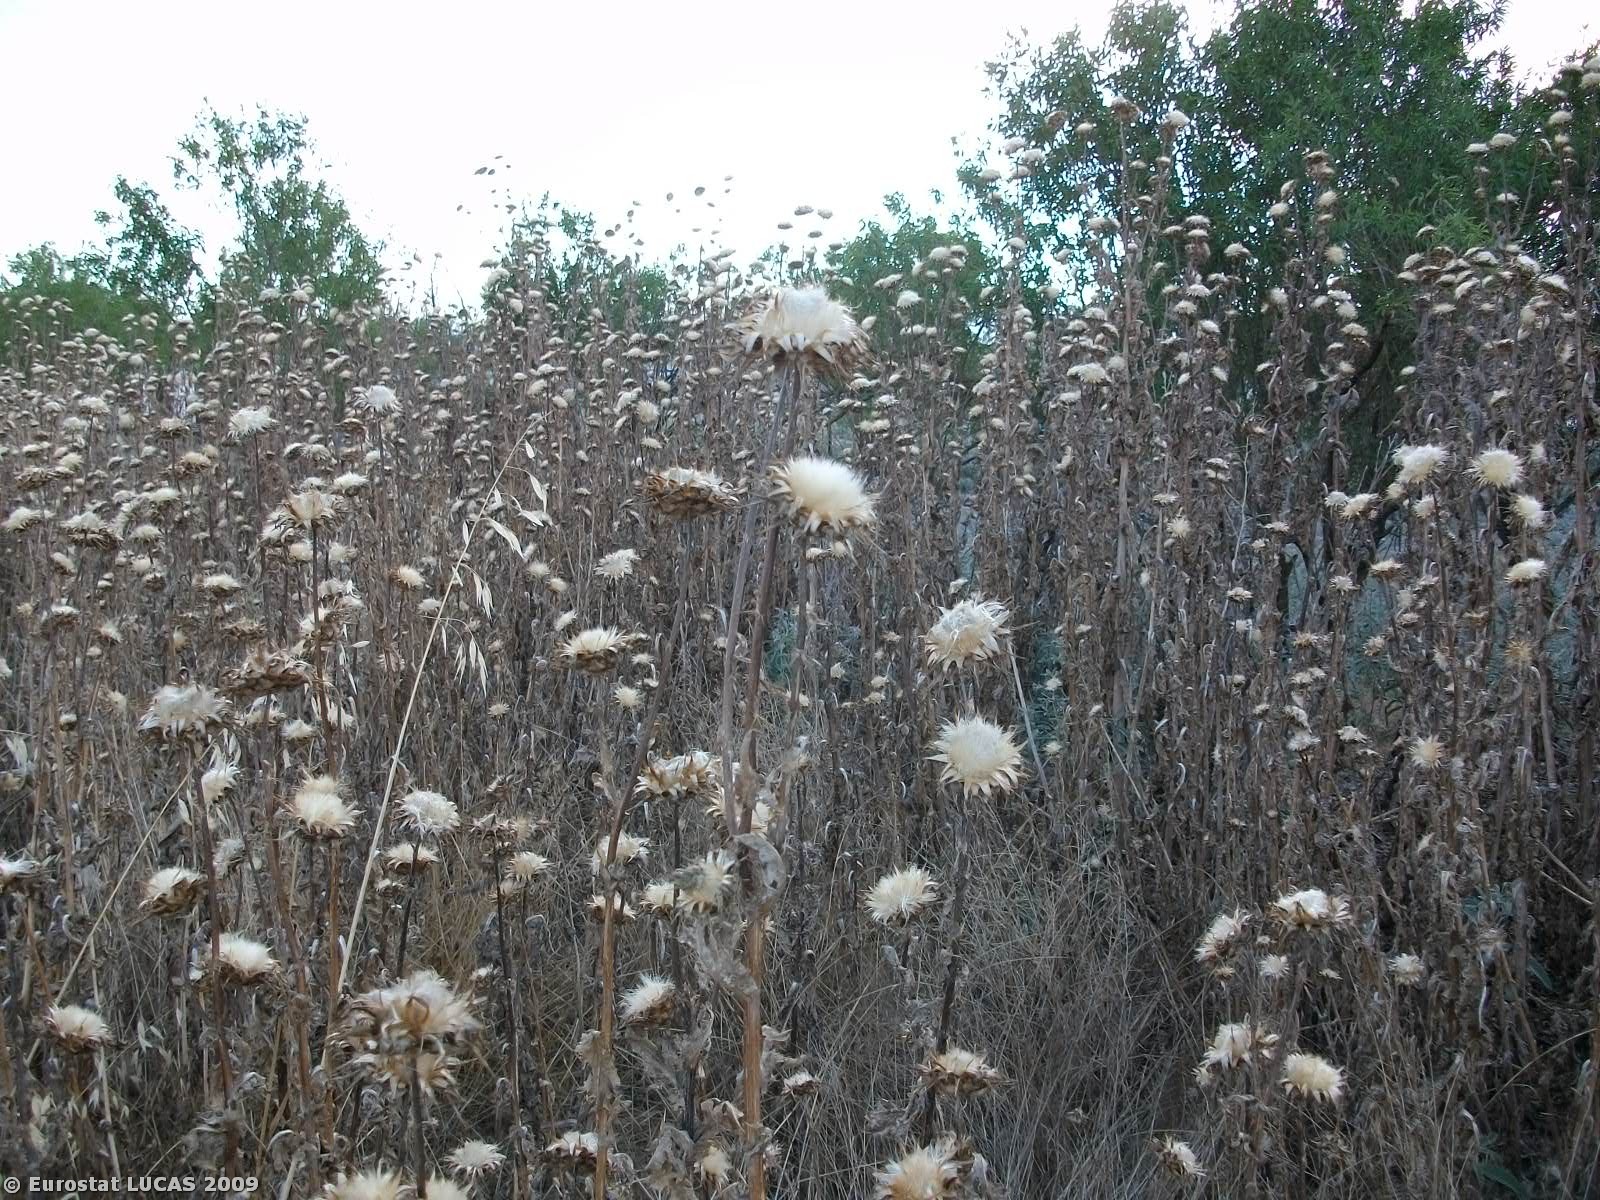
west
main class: Grassland
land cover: Spontaneously vegetated surfaces
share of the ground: > 75 %
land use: Fallow land
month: June
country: GR
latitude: 39.6569
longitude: 22.4262
